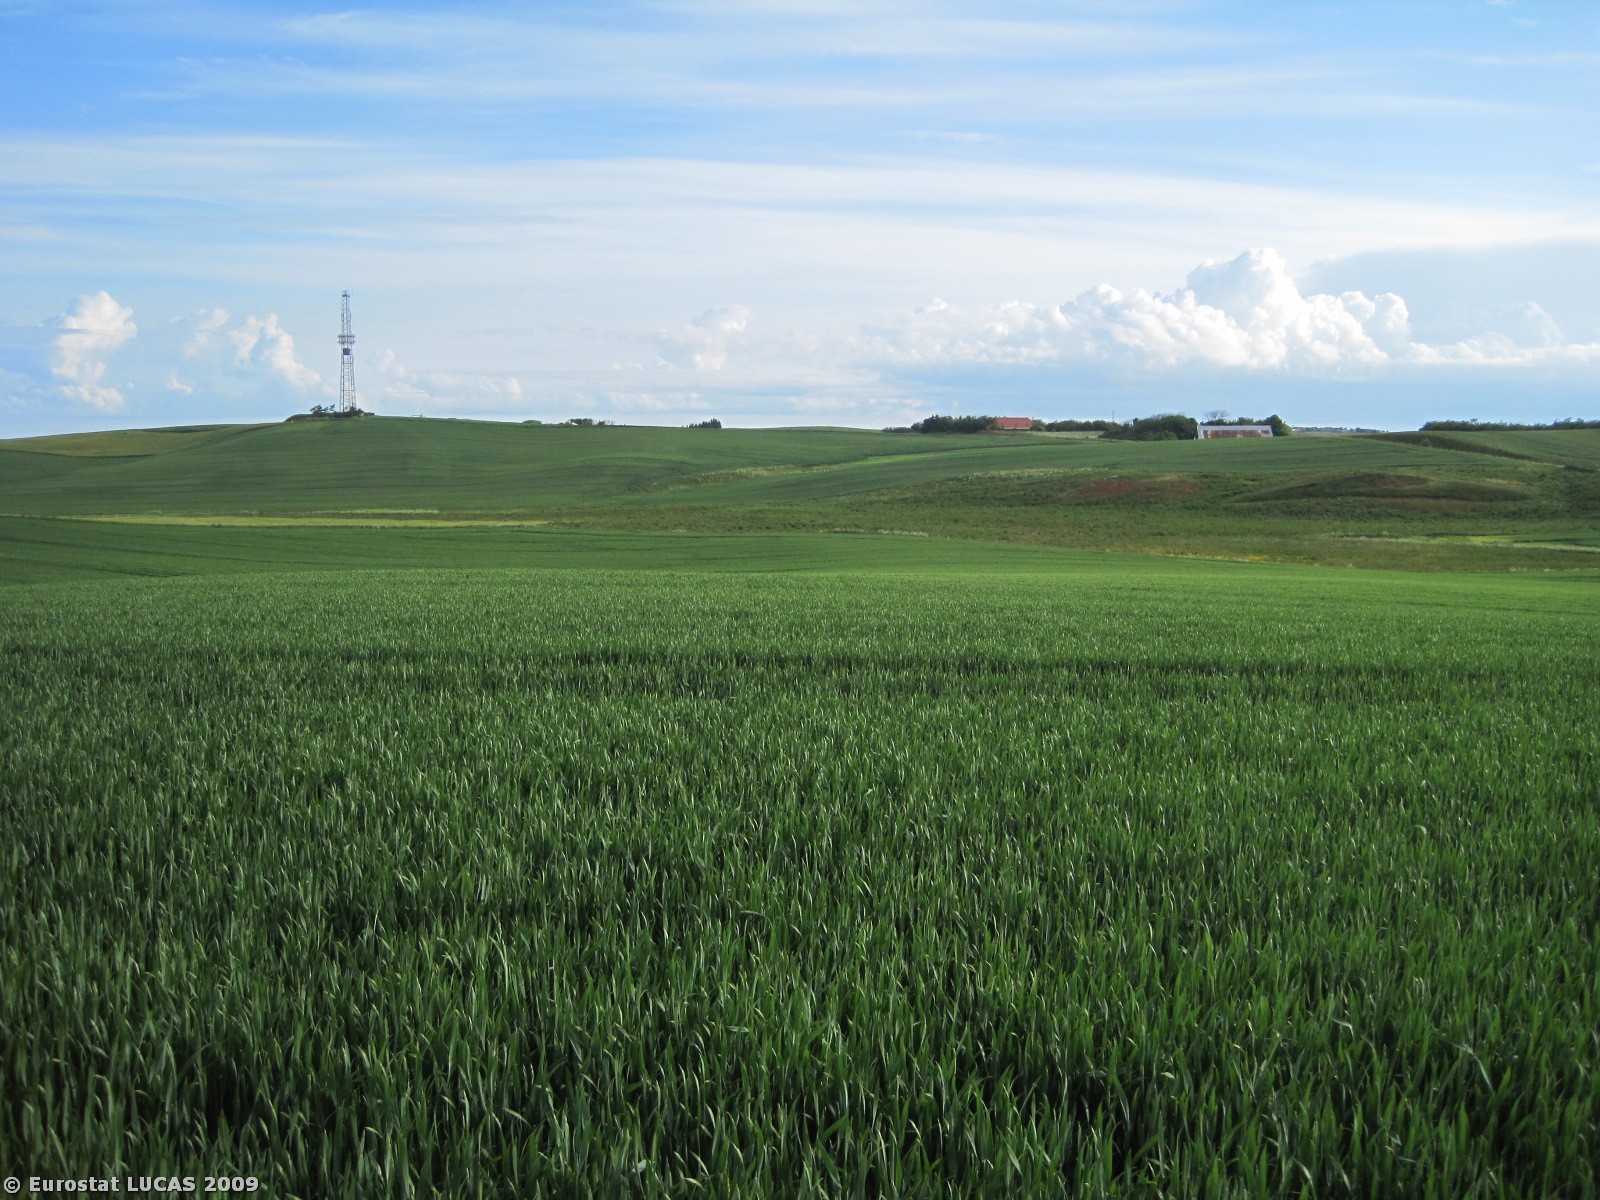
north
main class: Cropland
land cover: Common wheat
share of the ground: > 75 %
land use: Agriculture (excluding fallow land and kitchen gardens)
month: June
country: DK
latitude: 57.5361
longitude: 9.9833
